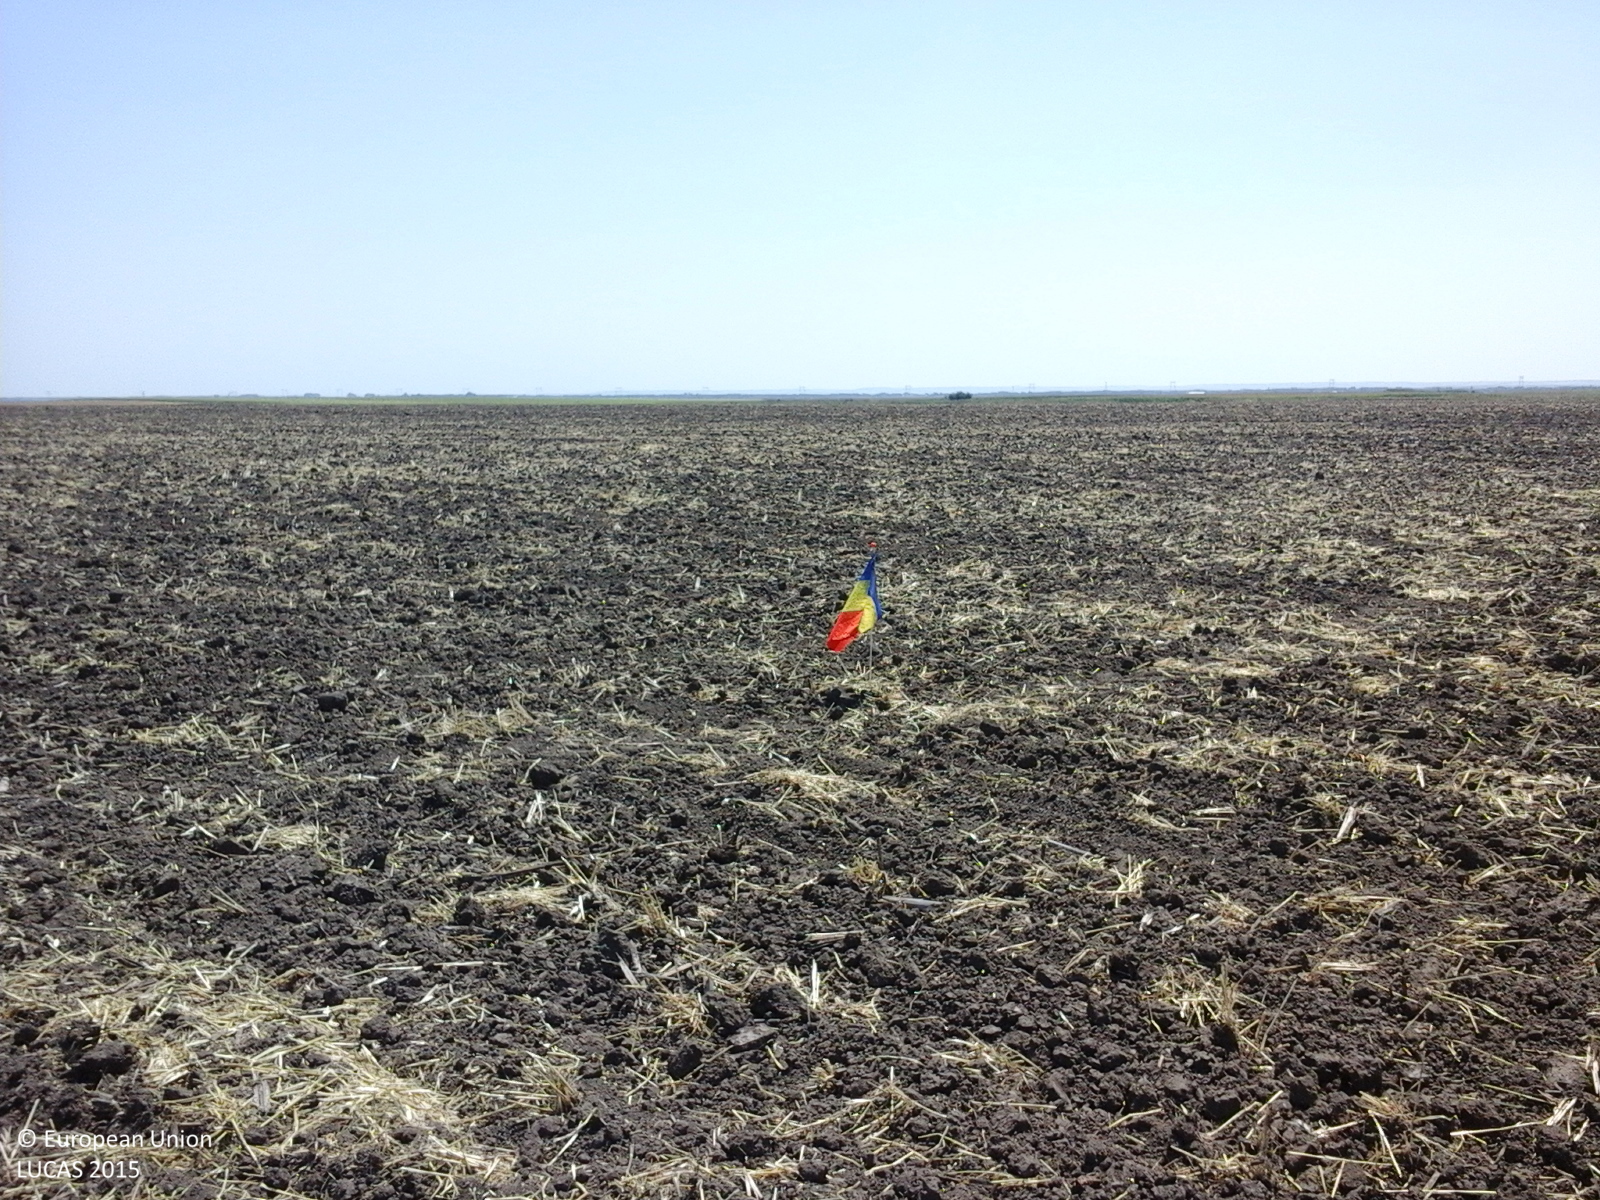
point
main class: Cropland
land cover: Common wheat
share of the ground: < 10 %
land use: Agriculture (excluding fallow land and kitchen gardens)
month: July
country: RO
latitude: 44.2347
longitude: 27.0420
